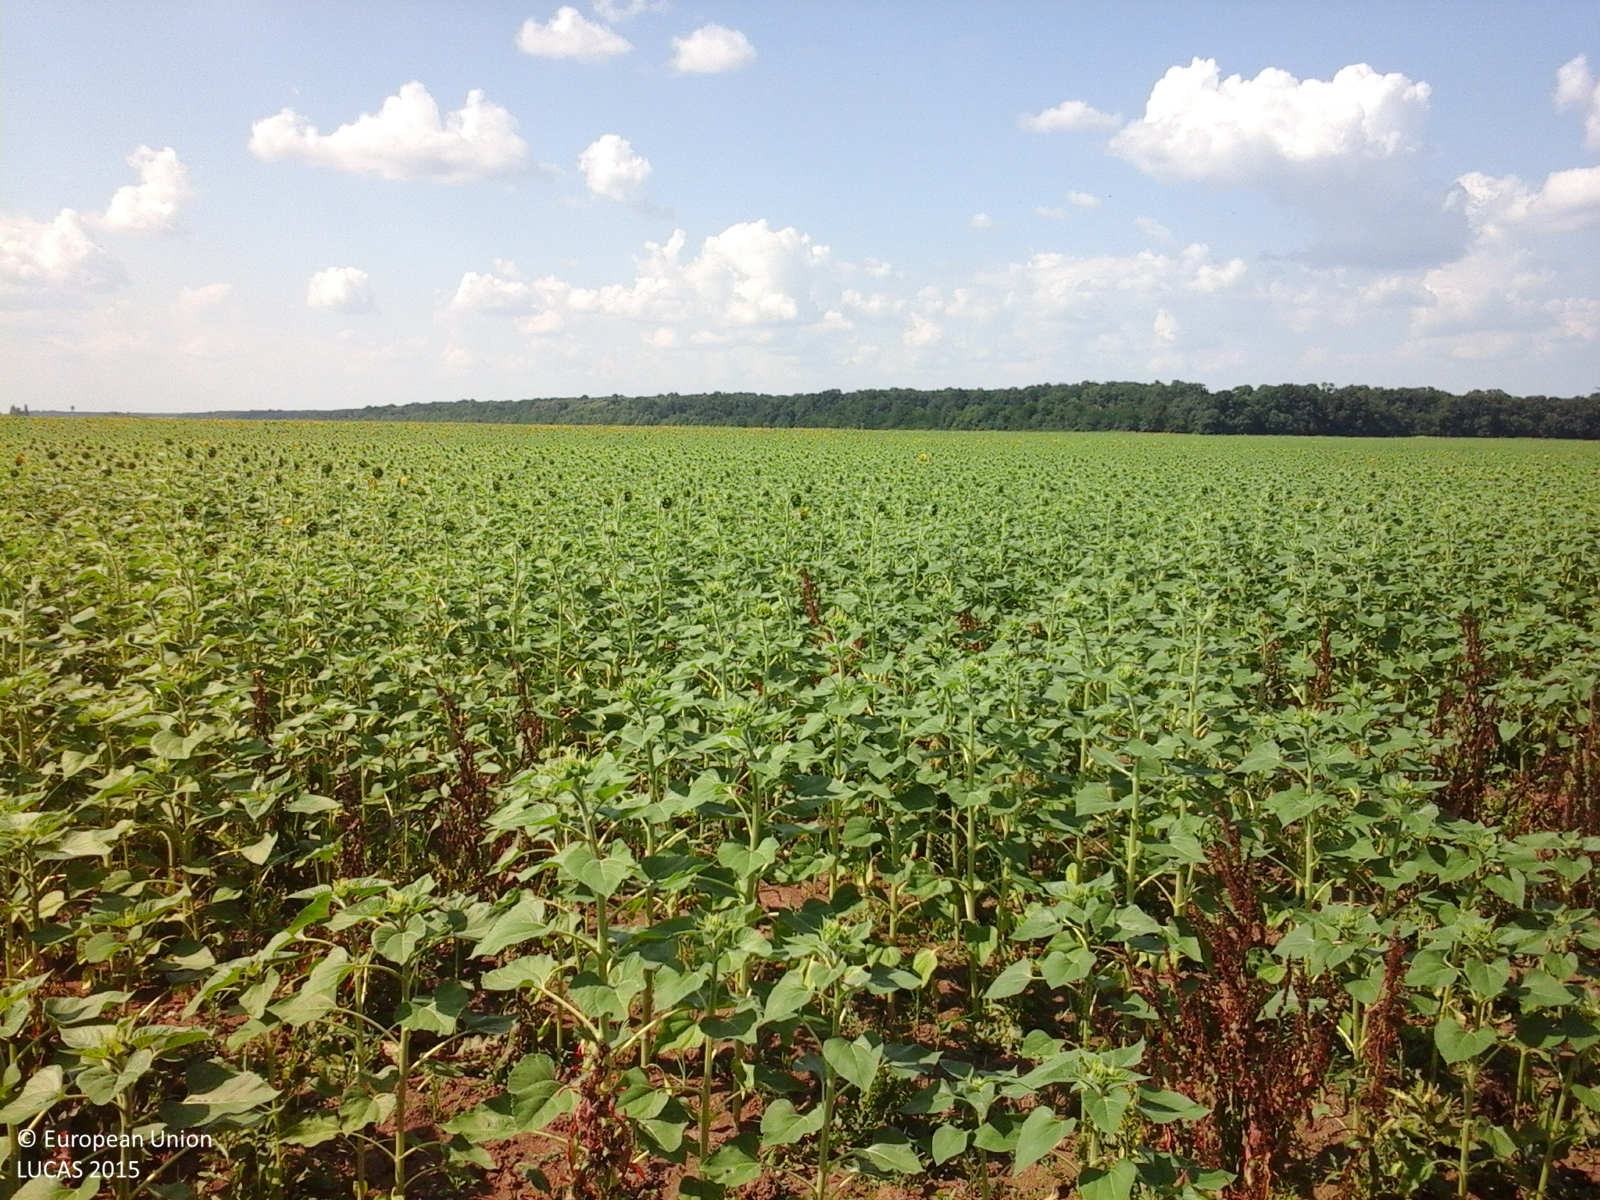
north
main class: Cropland
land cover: Sunflower
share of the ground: 50 - 75 %
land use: Agriculture (excluding fallow land and kitchen gardens)
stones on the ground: < 10 %
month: July
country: RO
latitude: 44.3588
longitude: 25.6903
